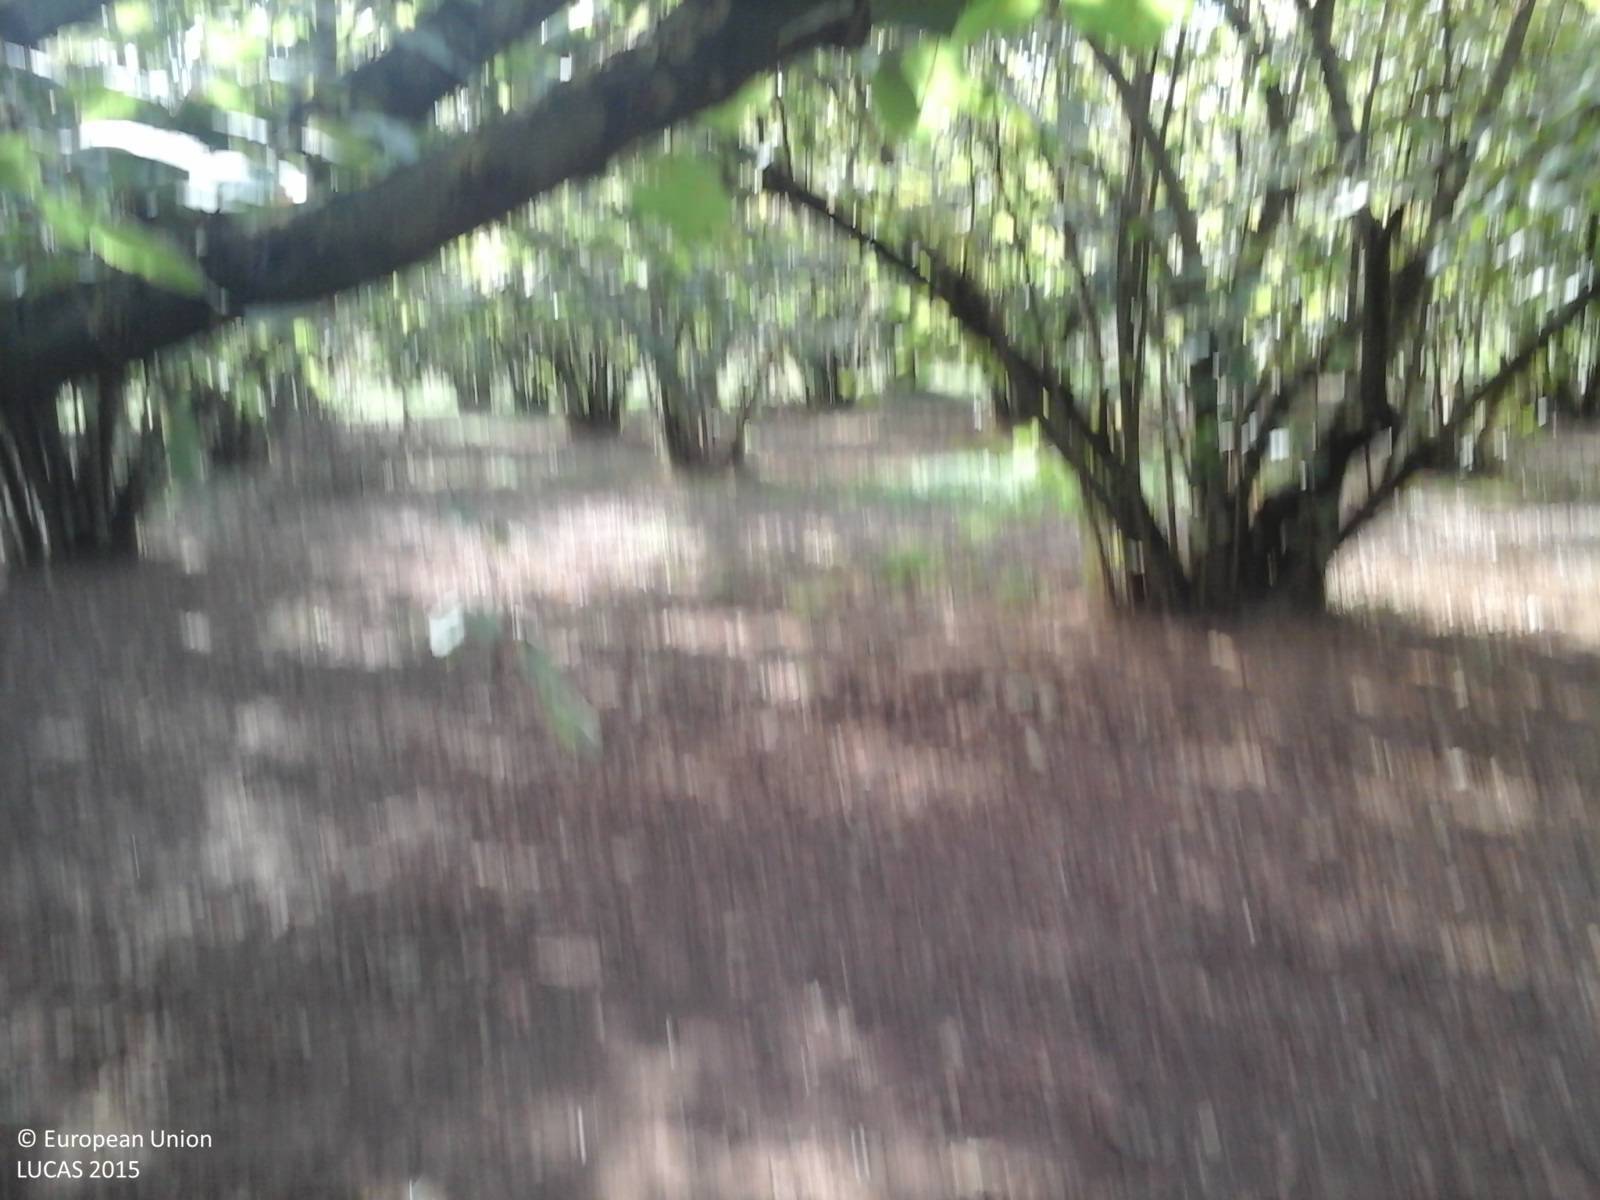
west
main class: Cropland
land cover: Nuts trees
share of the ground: > 75 %
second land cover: Other bare soil
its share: > 75 %
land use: Agriculture (excluding fallow land and kitchen gardens)
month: September
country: IT
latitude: 42.3741
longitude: 12.3359
